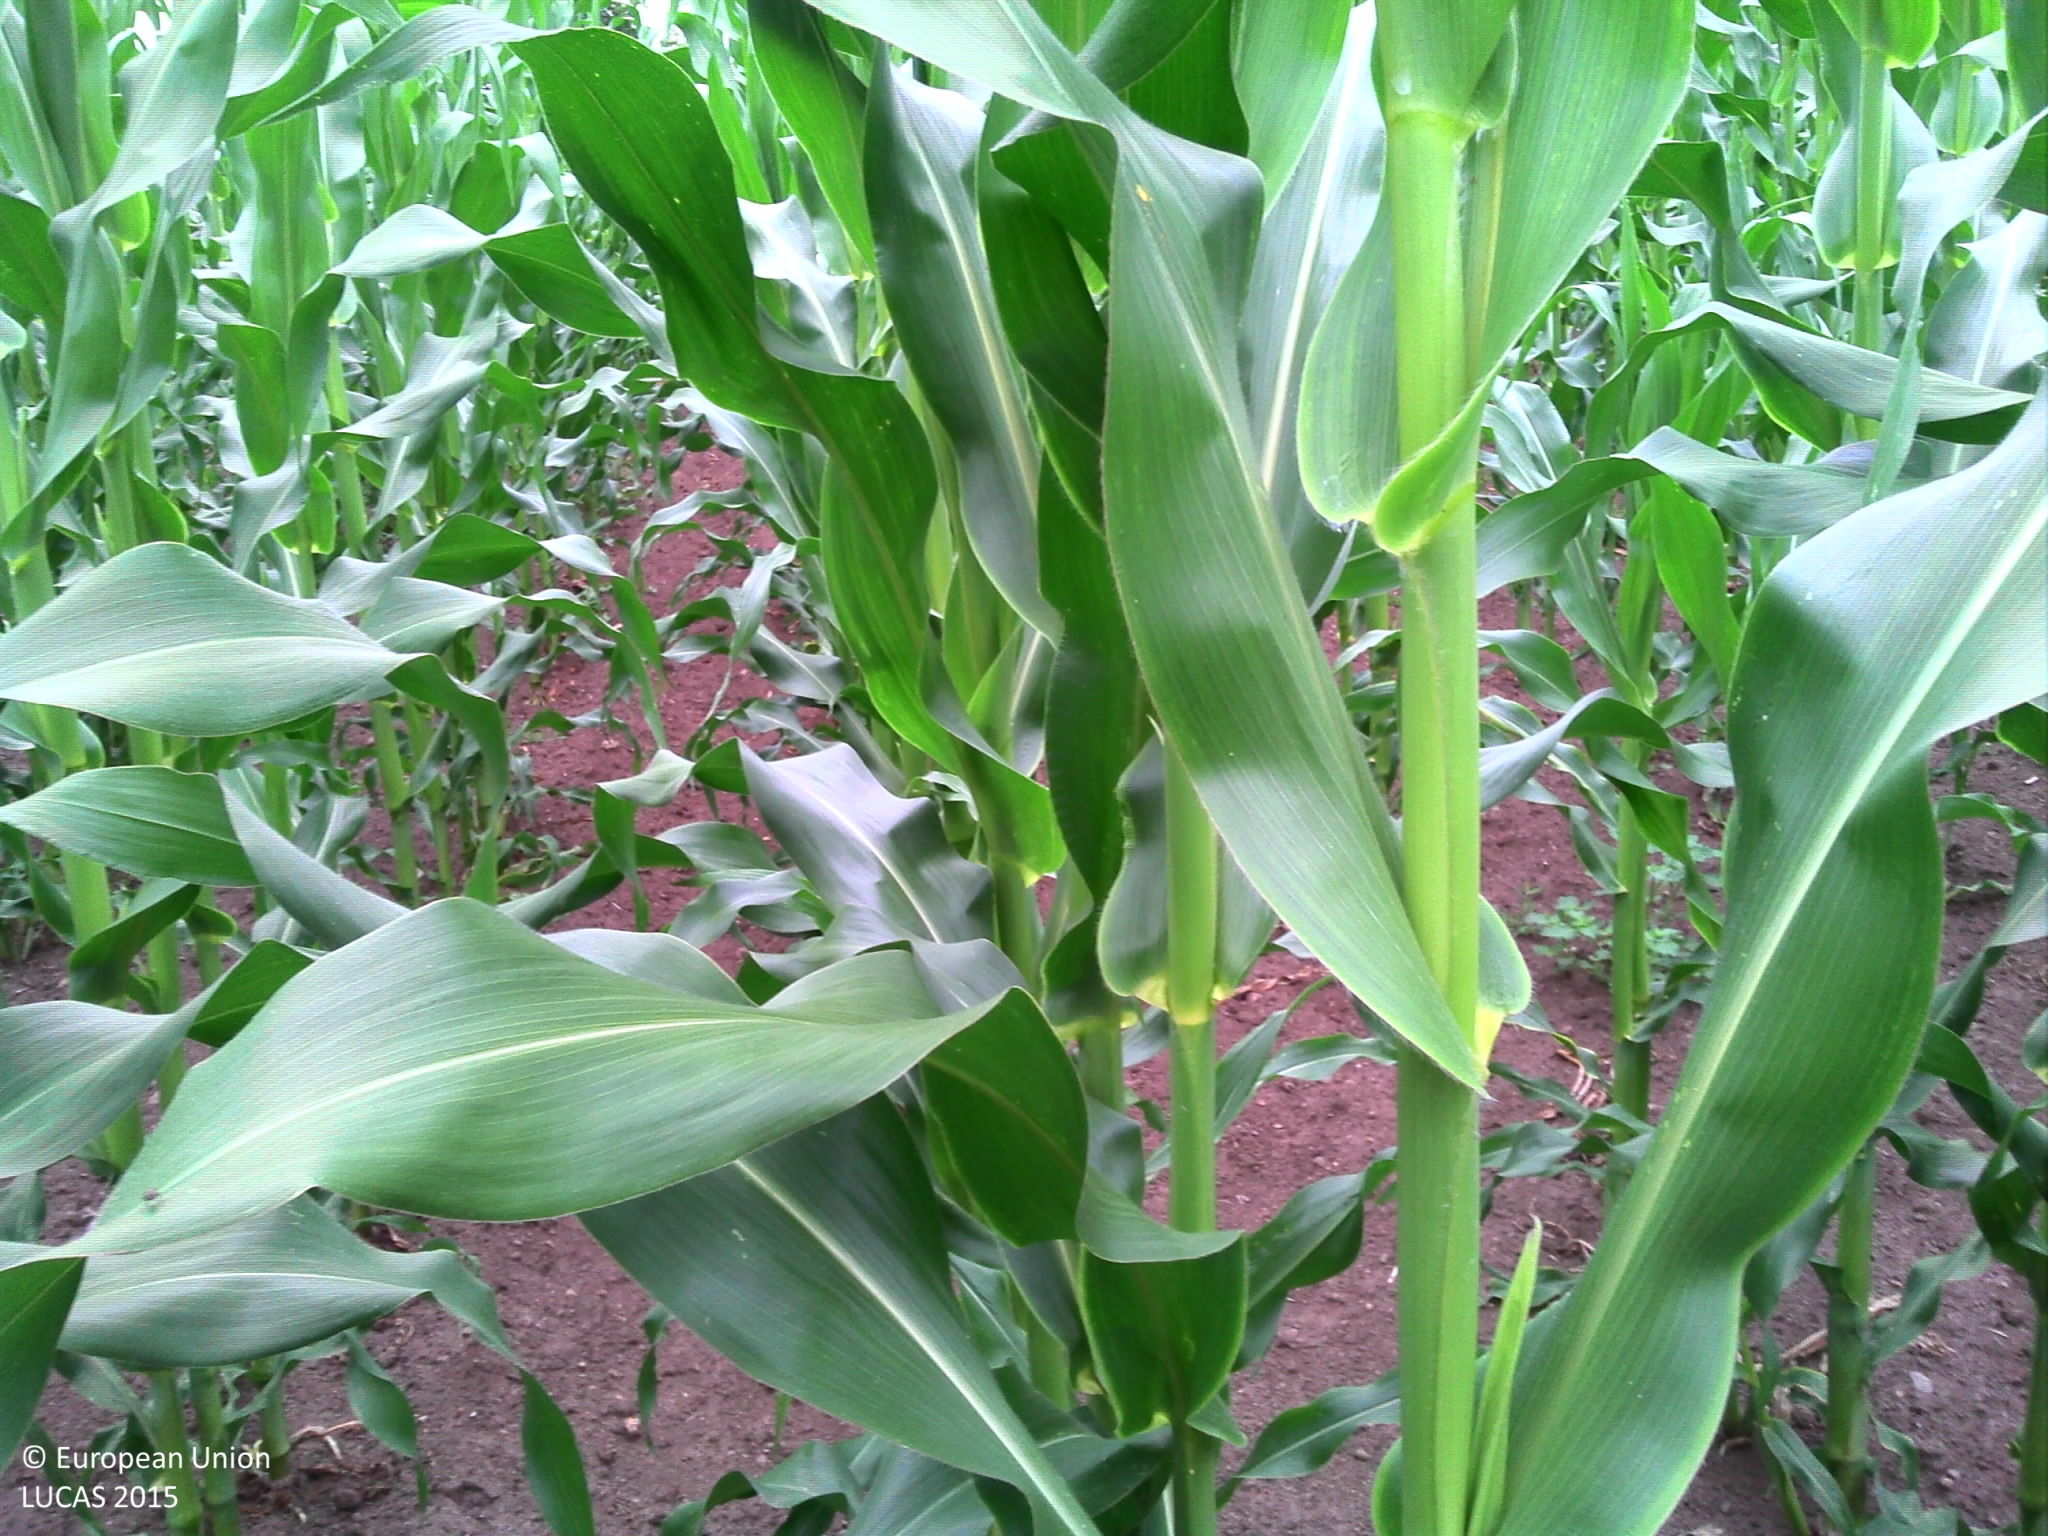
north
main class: Cropland
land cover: Maize
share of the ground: > 75 %
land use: Agriculture (excluding fallow land and kitchen gardens)
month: July
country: FR
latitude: 47.7462
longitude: -3.2617
